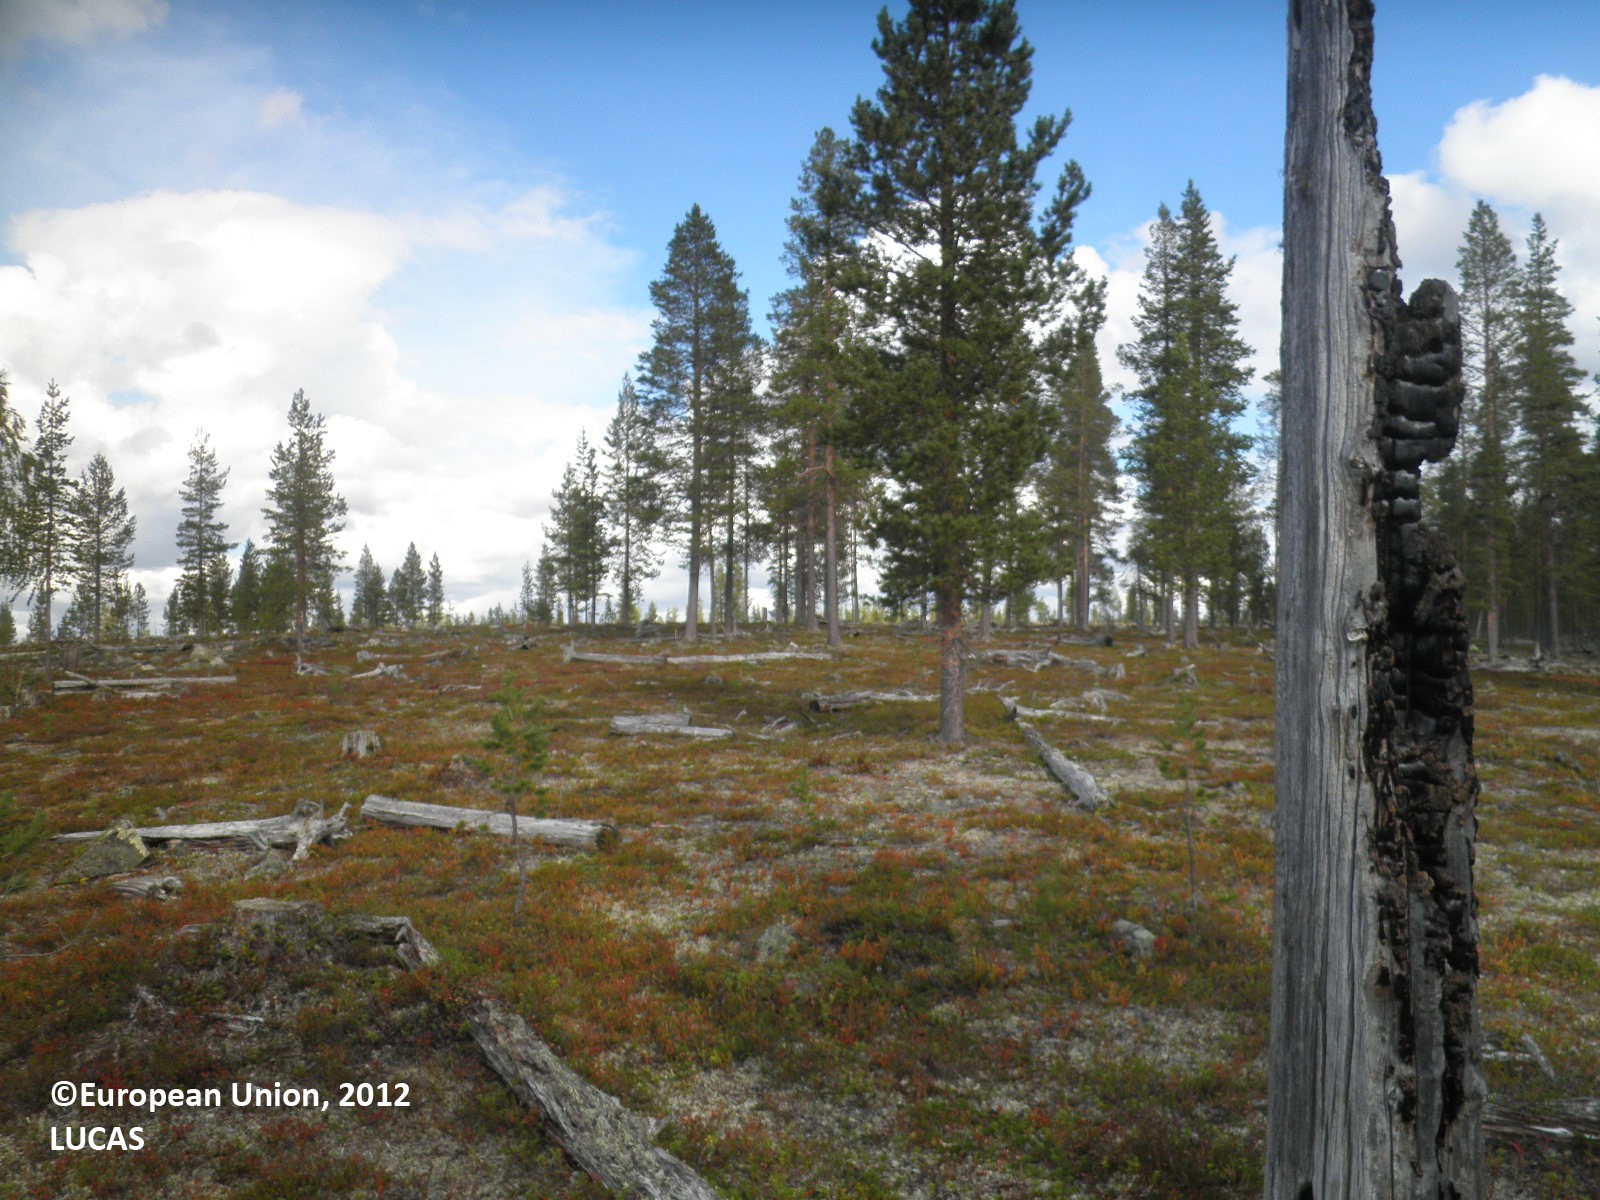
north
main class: Shrubland
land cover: Shrubland with sparse tree cover
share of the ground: > 75 %
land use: Forestry
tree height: > 5 m
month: August
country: FI
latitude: 68.0224
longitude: 28.2360
